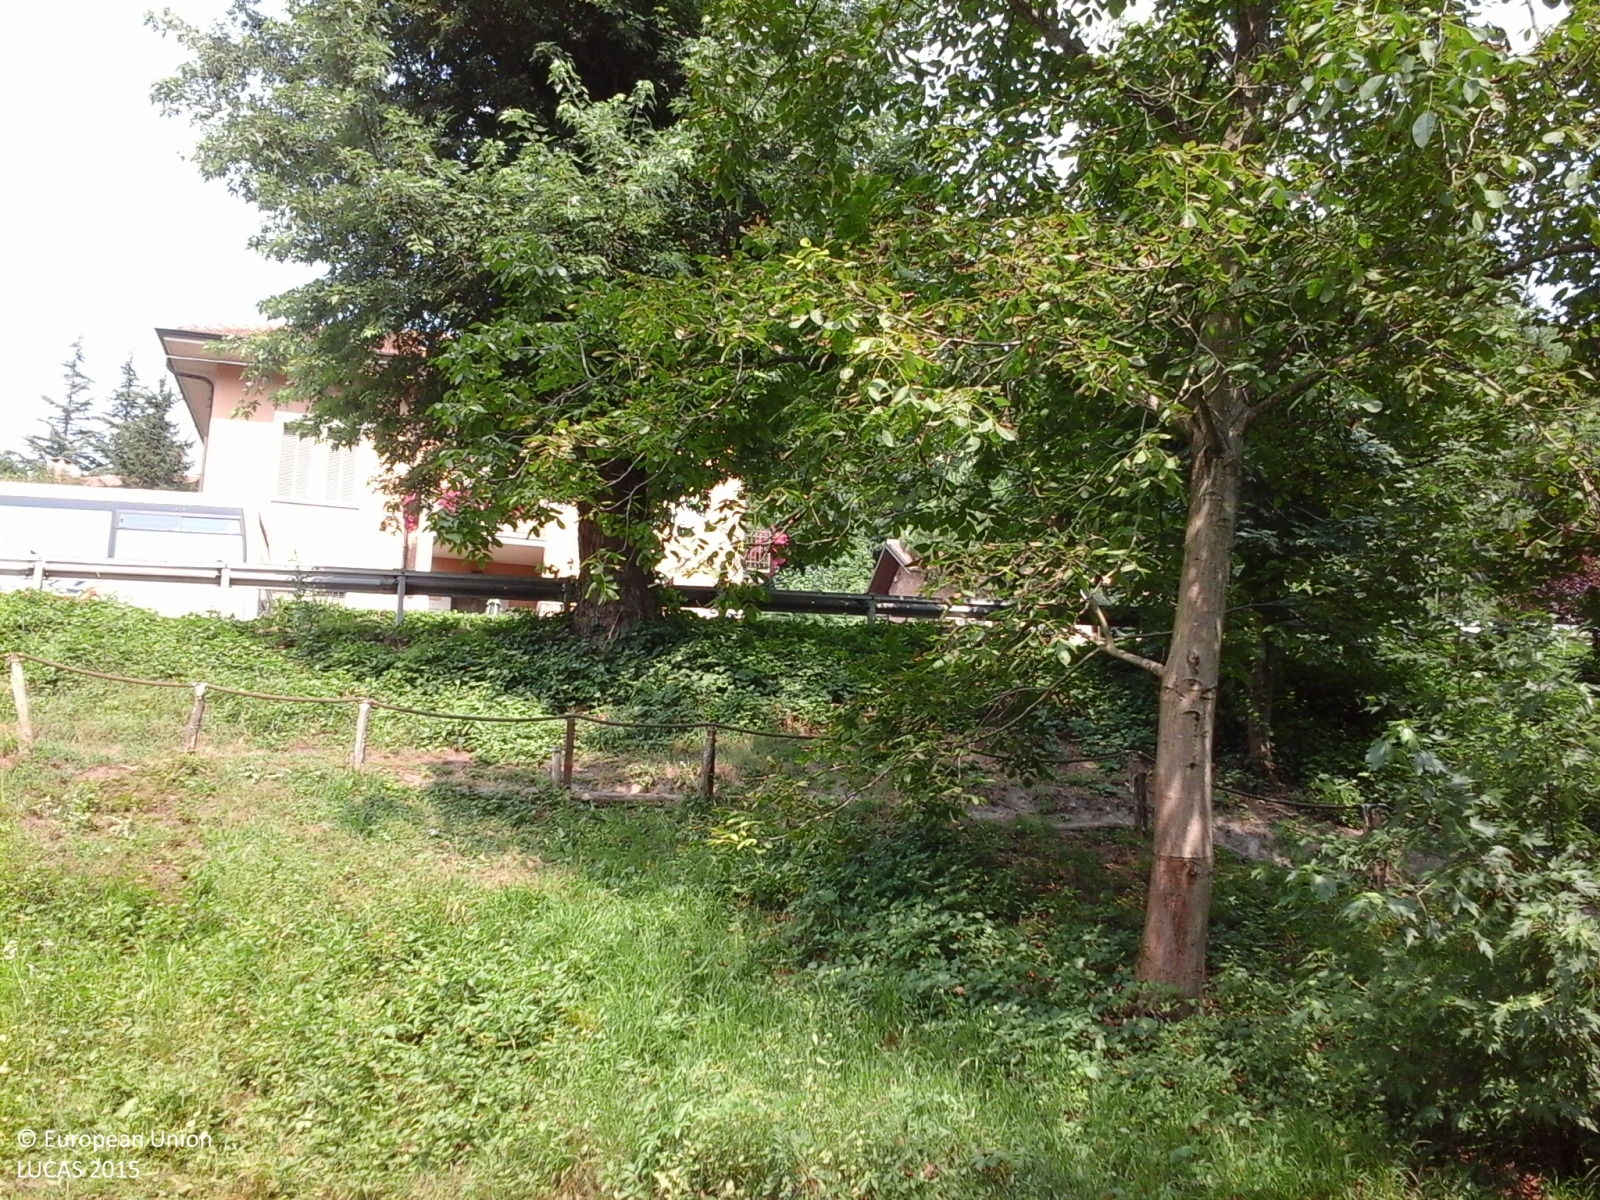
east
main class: Woodland
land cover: Broadleaved woodland
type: thermophilous deciduous forest
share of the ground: > 75 %
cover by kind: broadleaved forest trees 100 %
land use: Semi-natural and natural areas not in use
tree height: > 5 m
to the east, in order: Broadleaved woodland; Inland fresh running water; Broadleaved woodland; Grassland without tree/shrub cover; Fences; Broadleaved woodland; Artificial constructions in urban areas; Broadleaved woodland
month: July
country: IT
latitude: 45.0653
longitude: 7.7307
